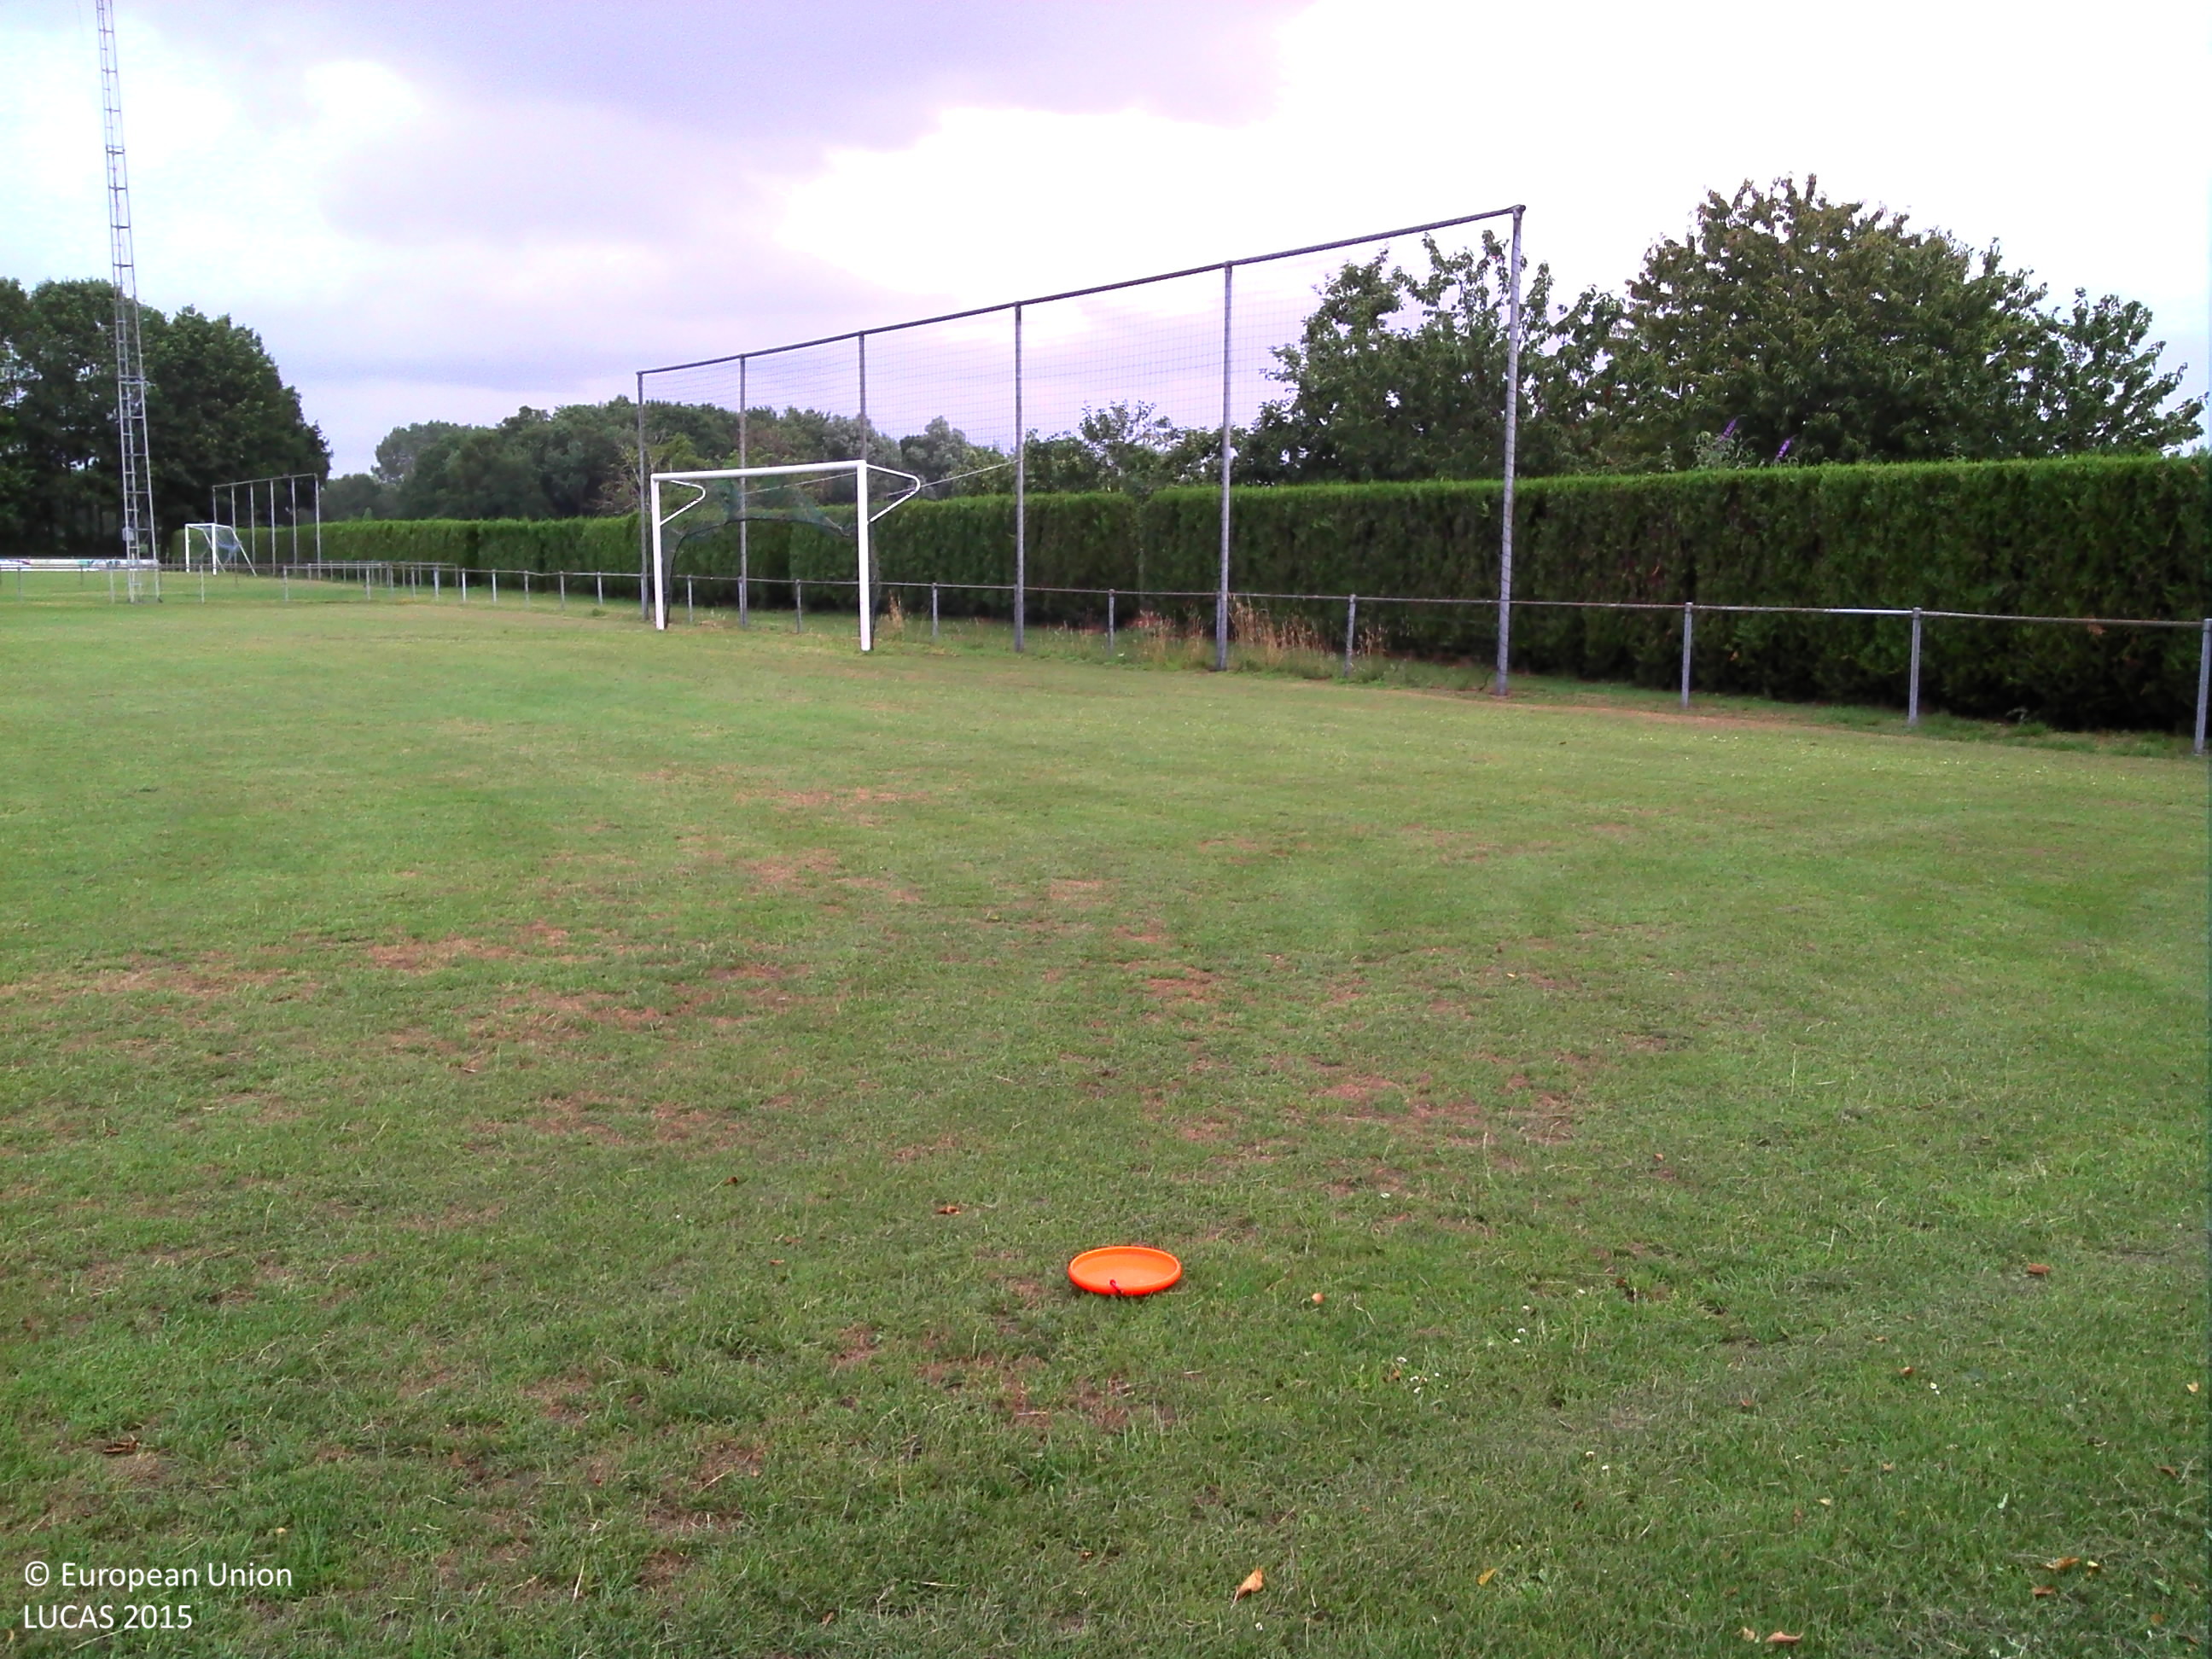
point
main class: Grassland
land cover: Grassland without tree/shrub cover
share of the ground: > 75 %
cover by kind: herbaceous plants 100 %
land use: Sport
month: July
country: BE
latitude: 51.2485
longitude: 5.5140
